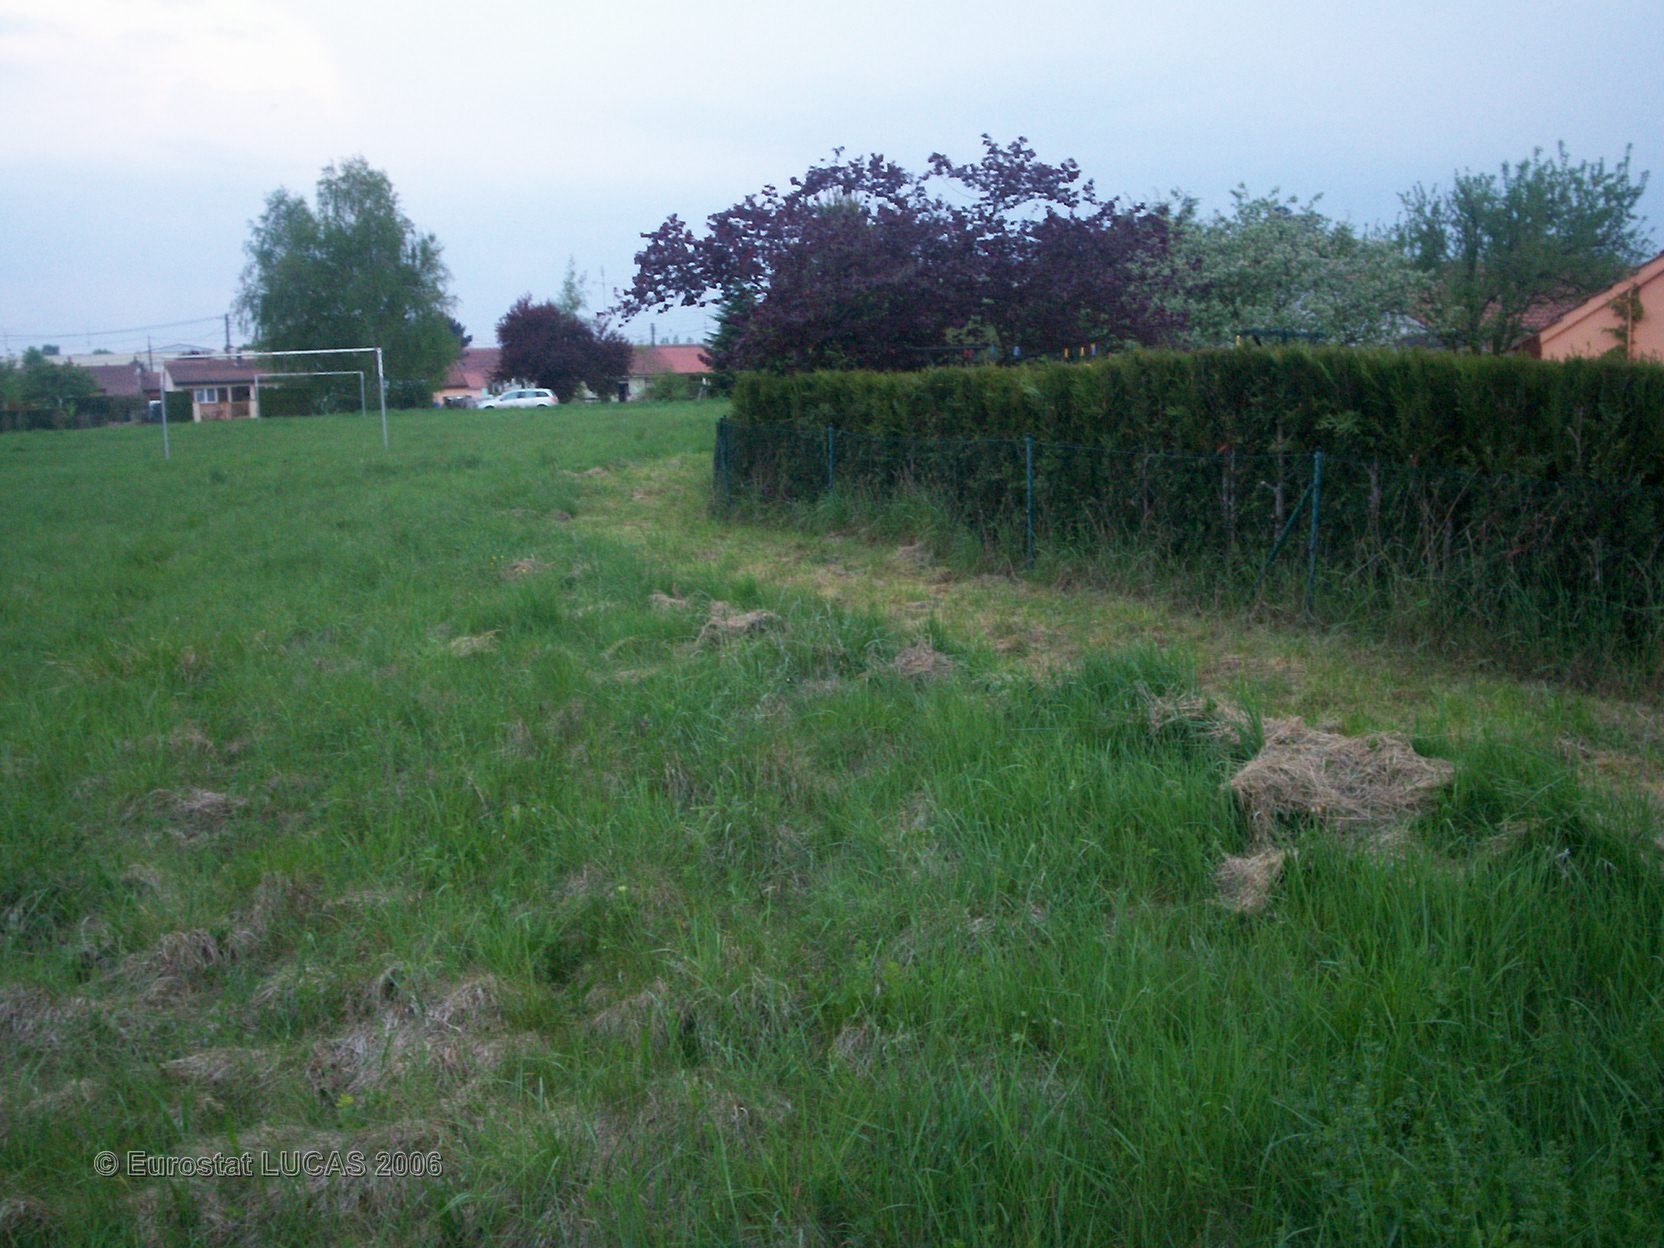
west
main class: Grassland
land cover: Grassland without tree/shrub cover
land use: Agriculture (excluding fallow land and kitchen gardens)
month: May
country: FR
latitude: 48.7430
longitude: 7.0768
